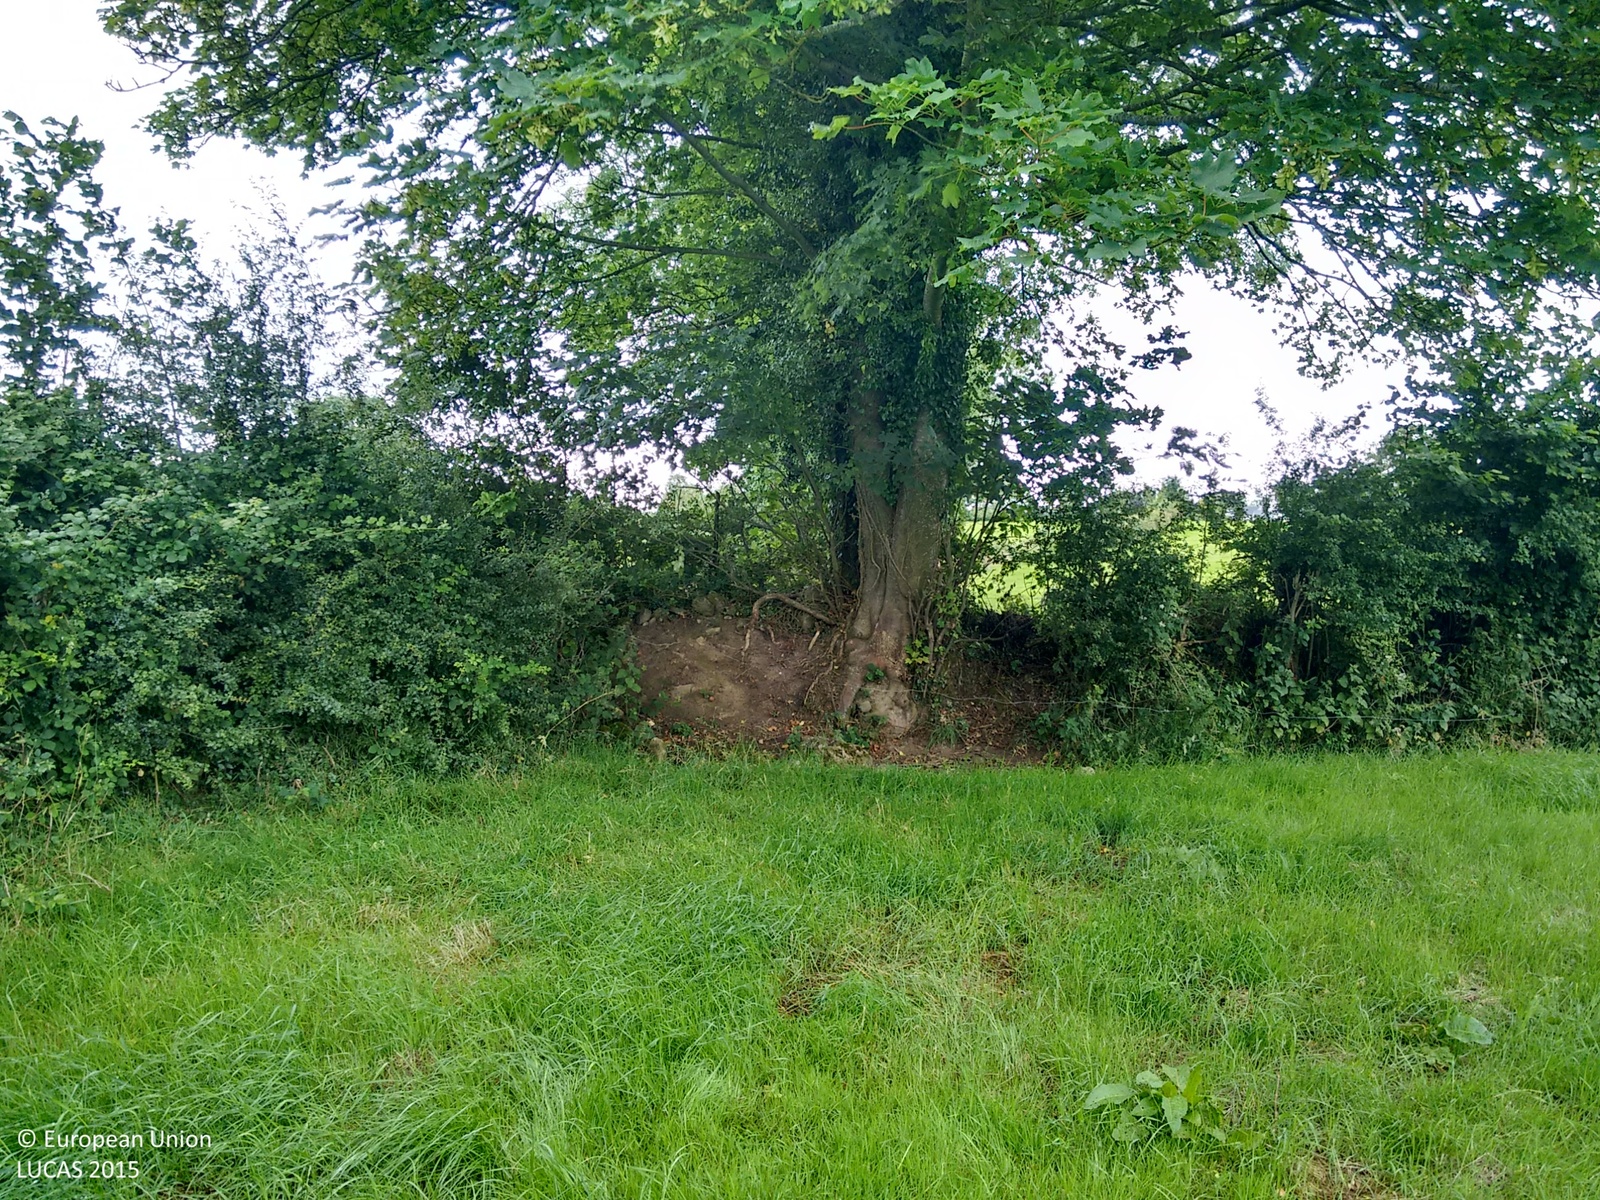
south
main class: Grassland
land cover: Grassland without tree/shrub cover
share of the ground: > 75 %
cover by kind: herbaceous plants 100 %
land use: Agriculture (excluding fallow land and kitchen gardens)
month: July
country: IE
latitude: 53.5763
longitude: -7.6987
